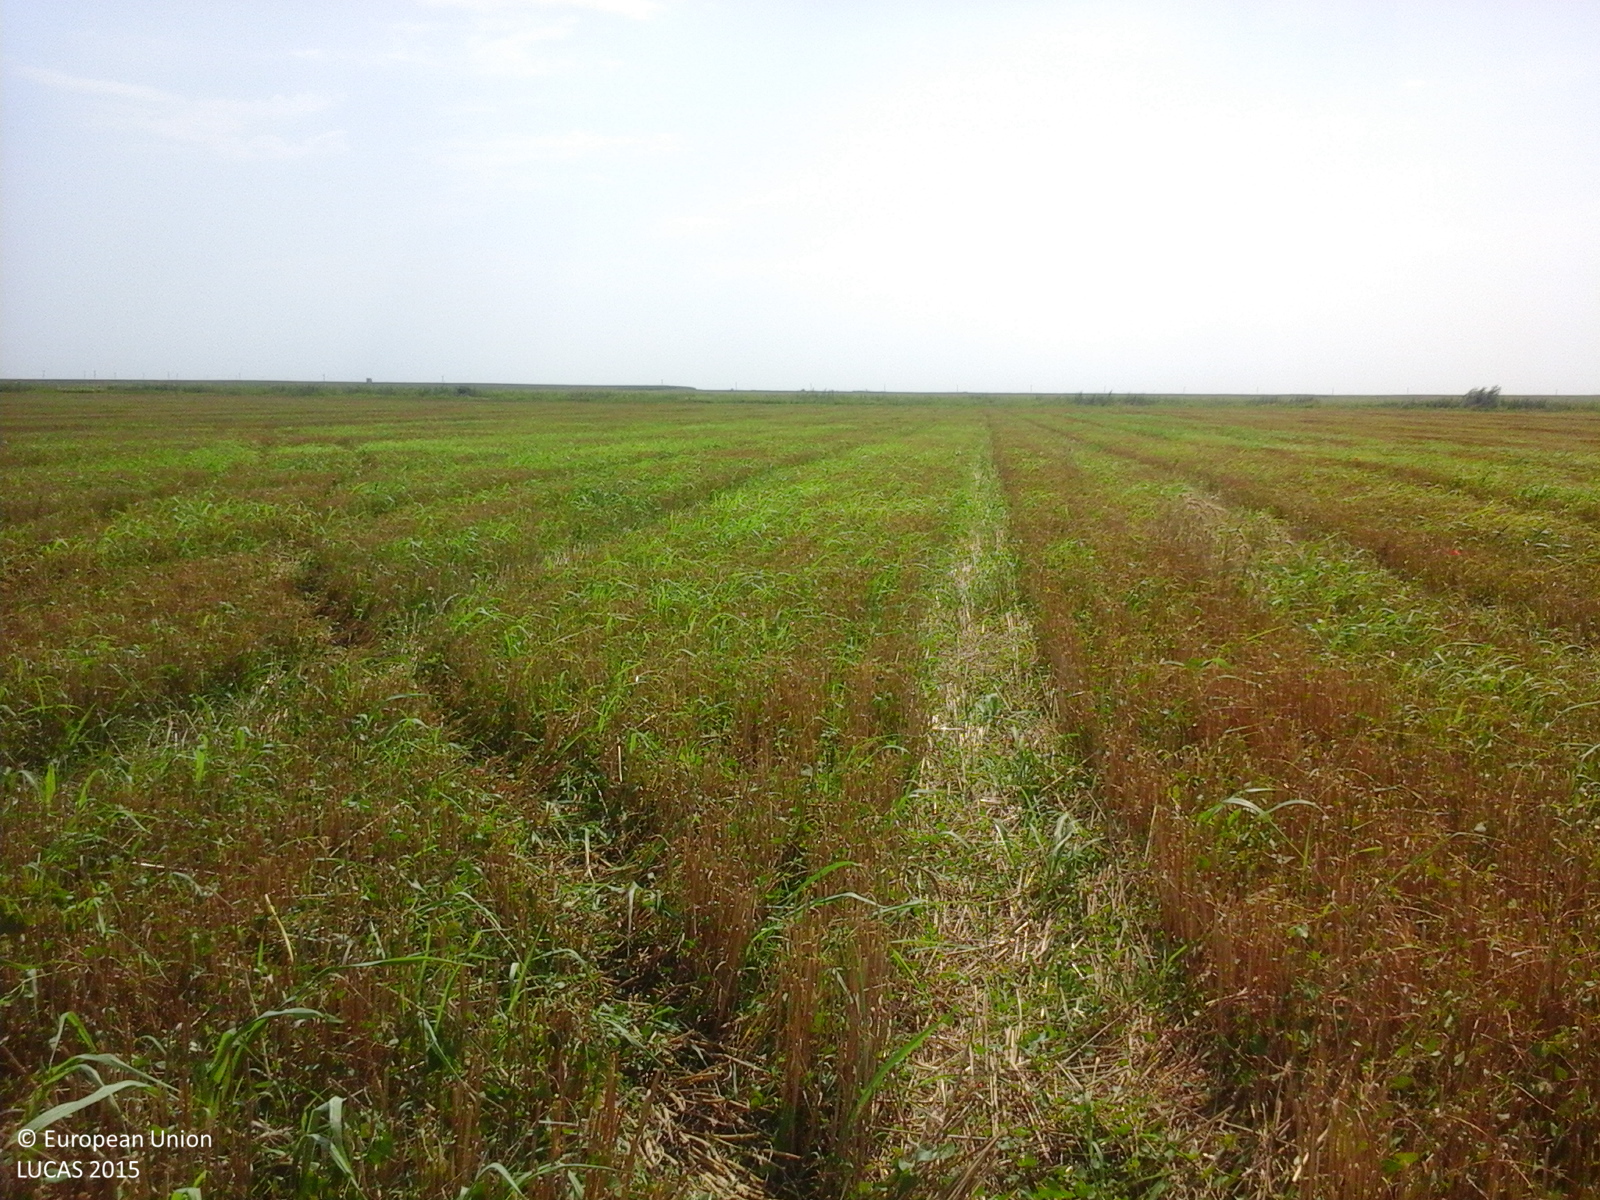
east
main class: Cropland
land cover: Common wheat
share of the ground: > 75 %
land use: Agriculture (excluding fallow land and kitchen gardens)
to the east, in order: Common wheat; Grass margins; Ditches and canals; Spontaneously vegetated surfaces; Sunflower
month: July
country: RO
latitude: 44.6762
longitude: 27.1527
